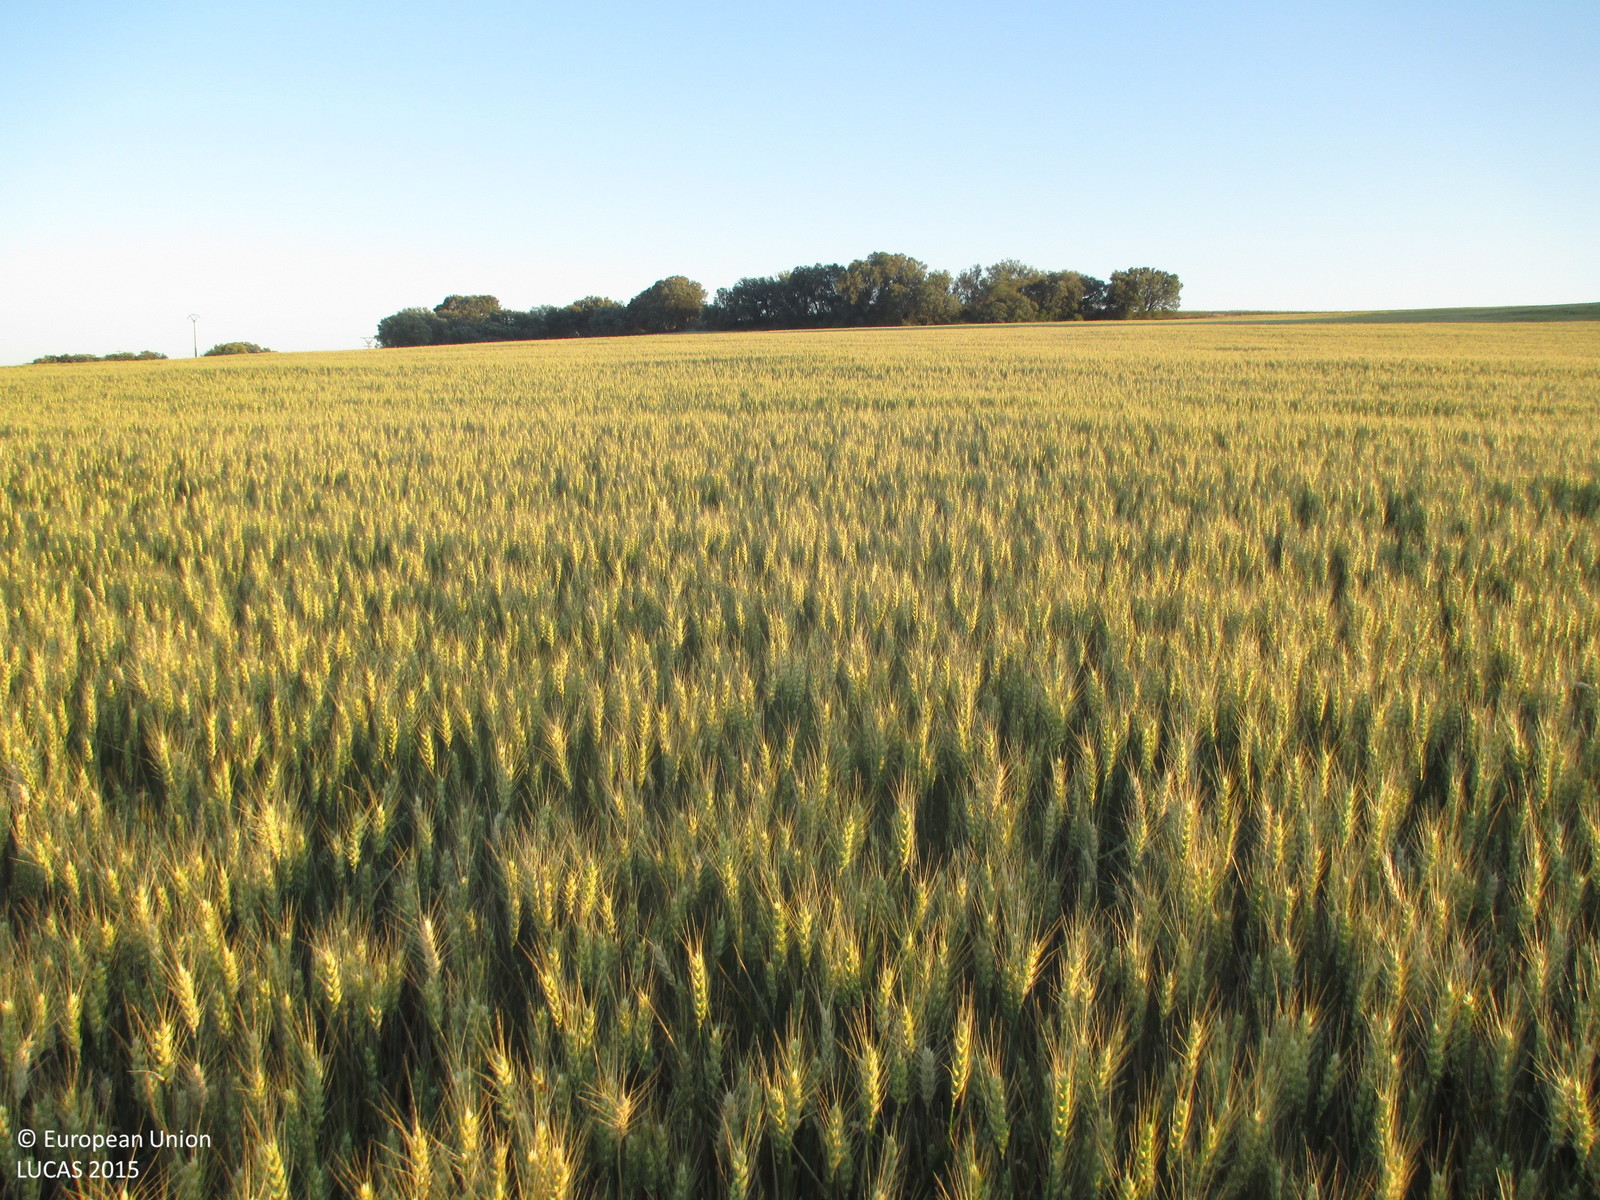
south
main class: Cropland
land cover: Common wheat
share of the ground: > 75 %
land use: Agriculture (excluding fallow land and kitchen gardens)
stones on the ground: < 10 %
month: May
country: ES
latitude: 42.0666
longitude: -0.1843
